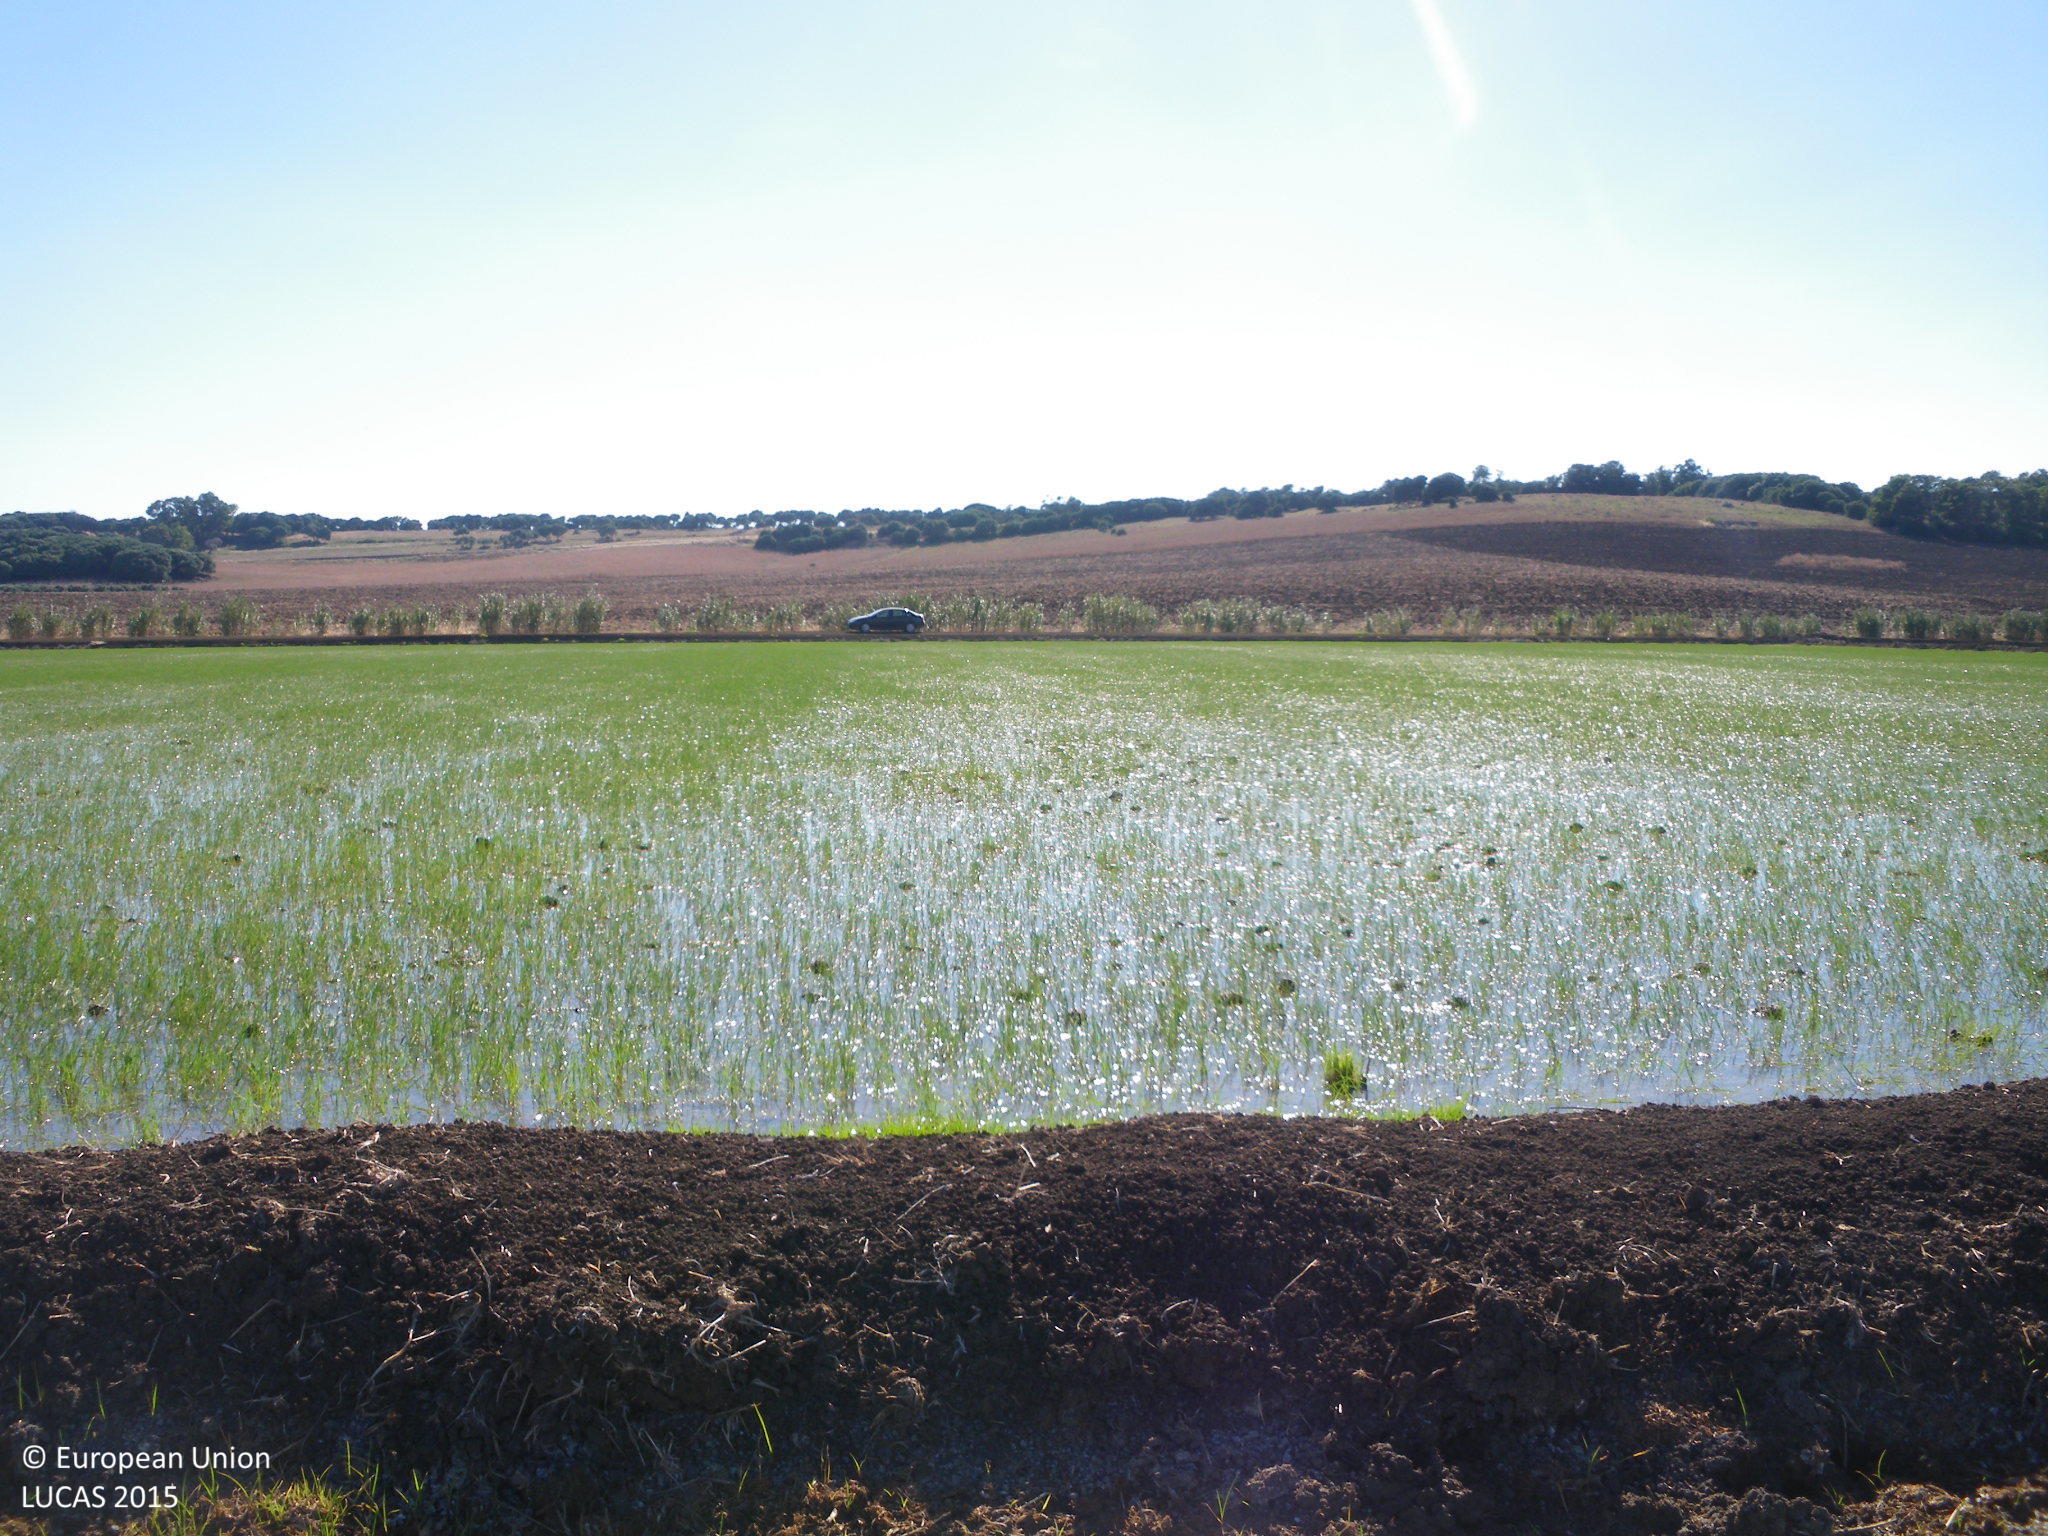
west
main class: Cropland
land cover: Rice
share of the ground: > 75 %
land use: Agriculture (excluding fallow land and kitchen gardens)
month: June
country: ES
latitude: 36.2383
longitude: -5.8775
